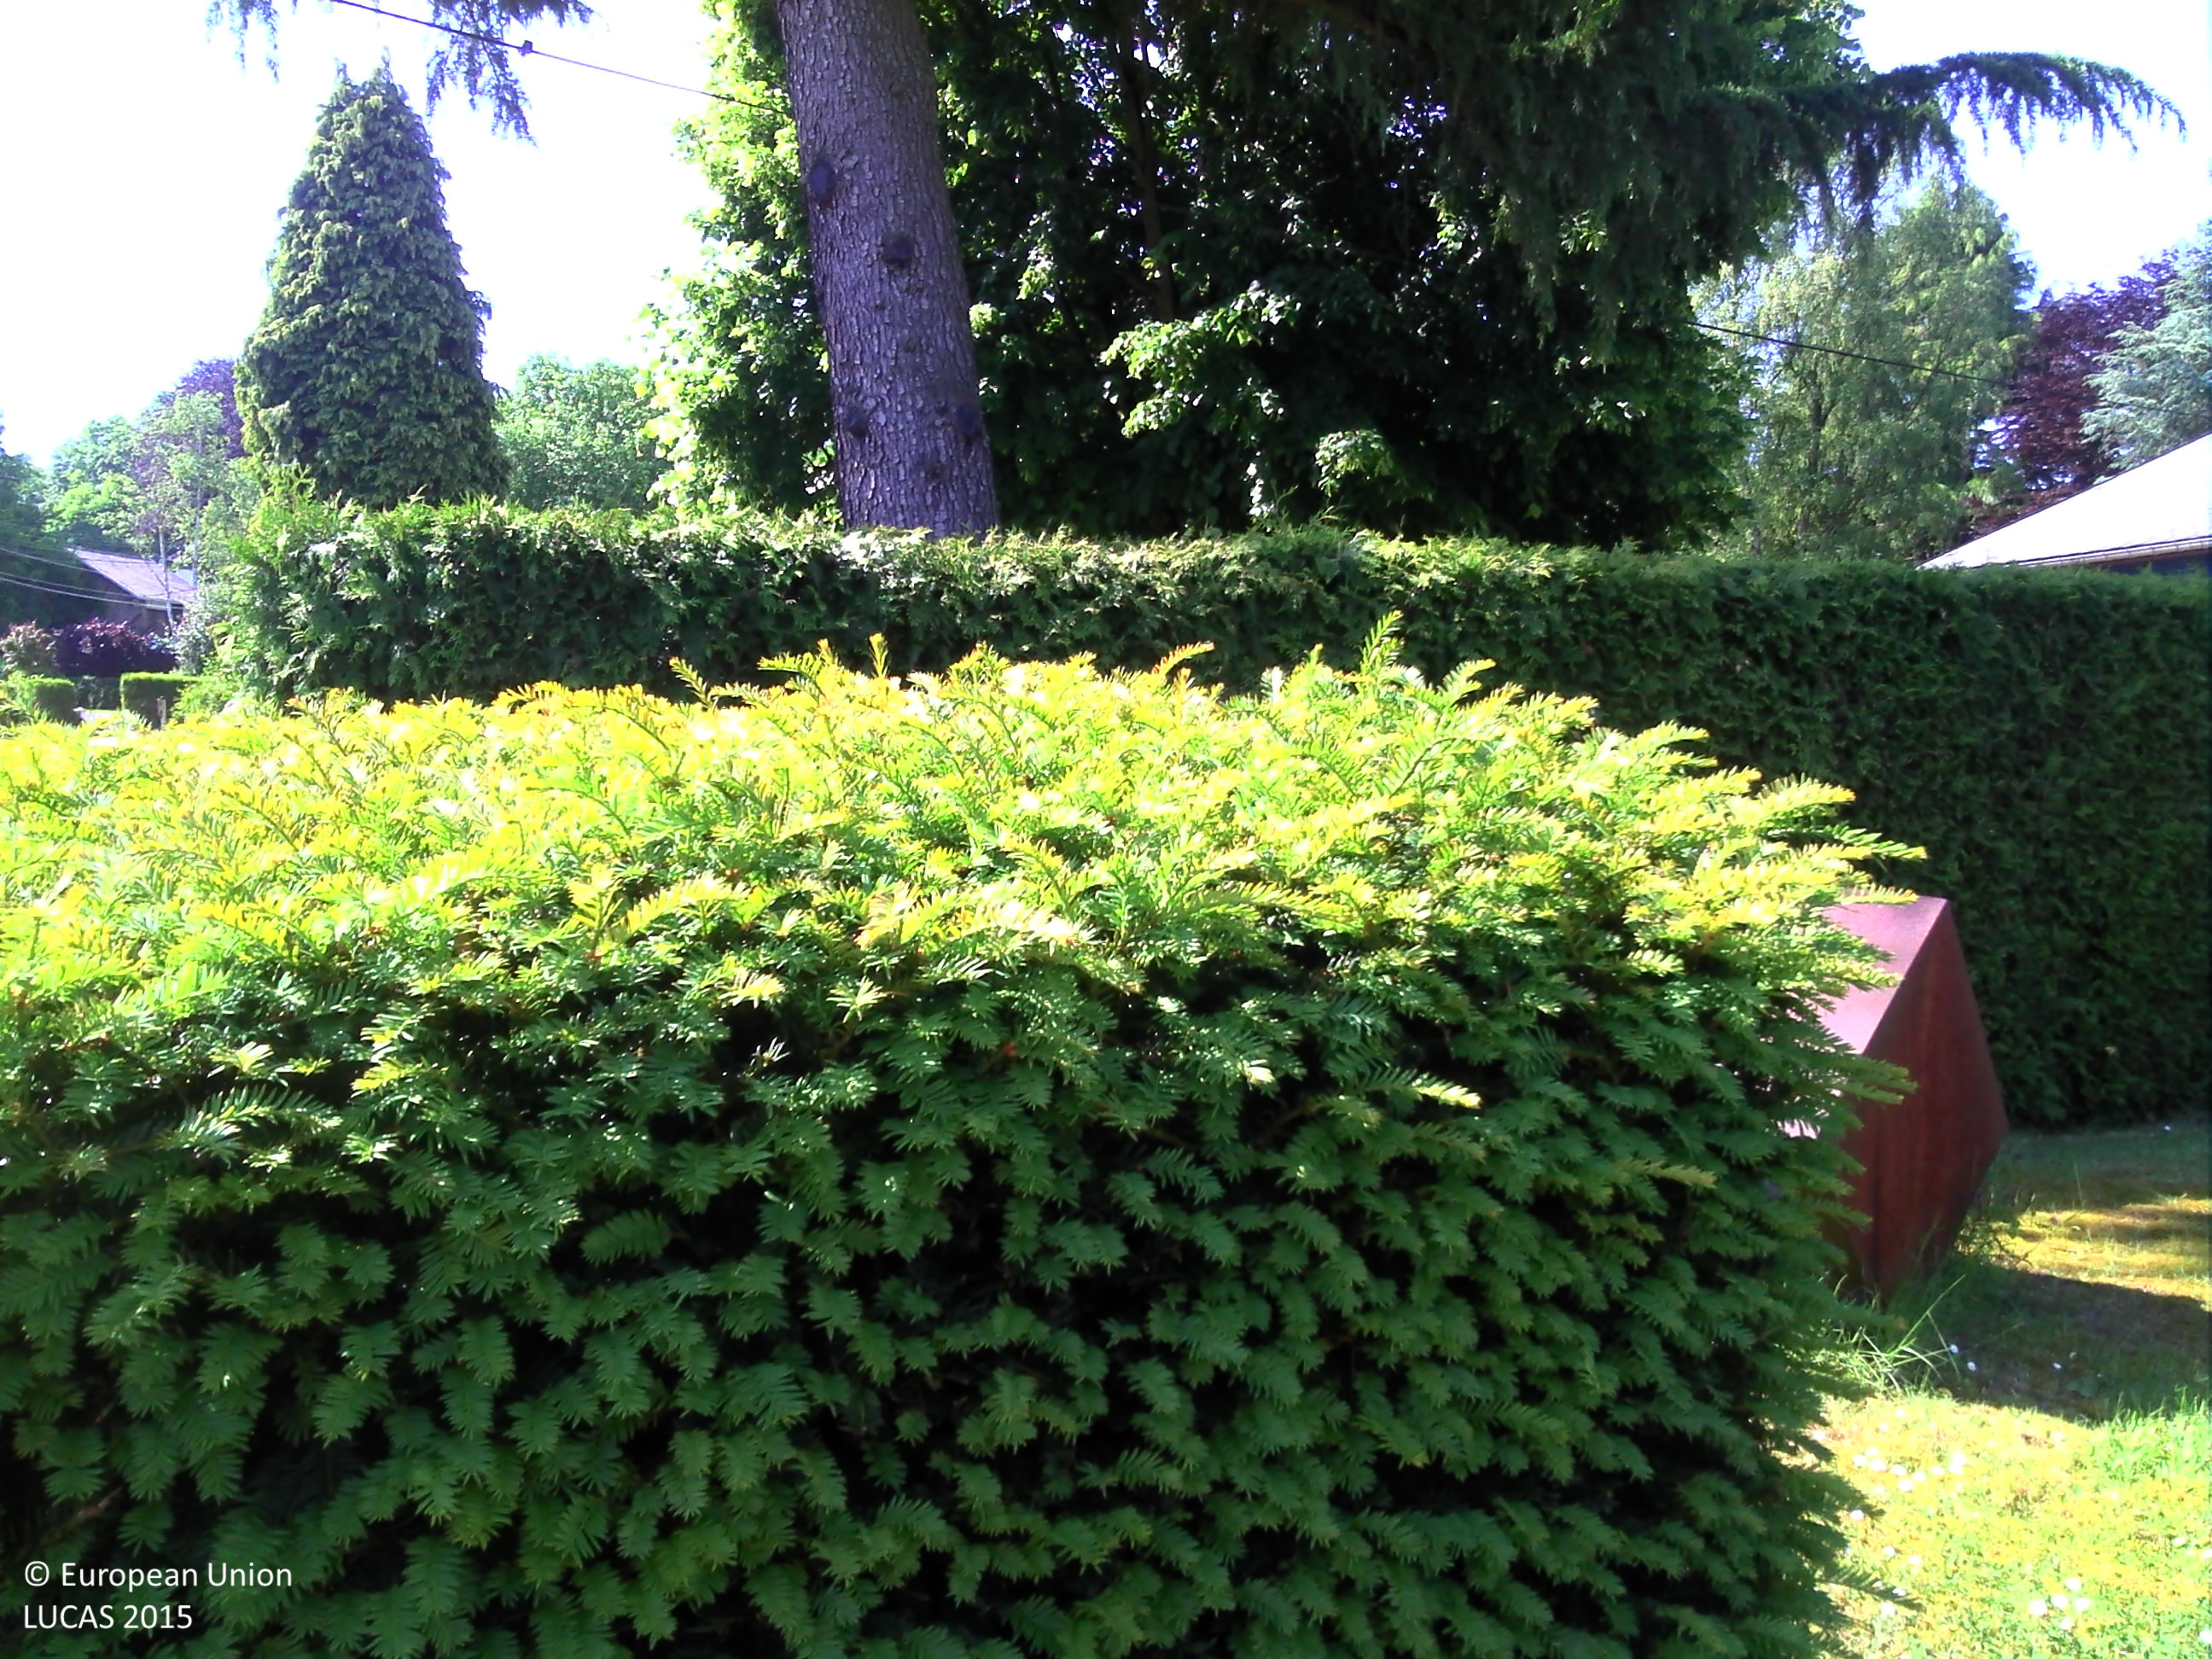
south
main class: Grassland
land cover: Grassland without tree/shrub cover
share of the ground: > 75 %
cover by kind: herbaceous plants 100 %
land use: Residential
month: June
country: BE
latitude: 50.5858
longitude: 5.6058
